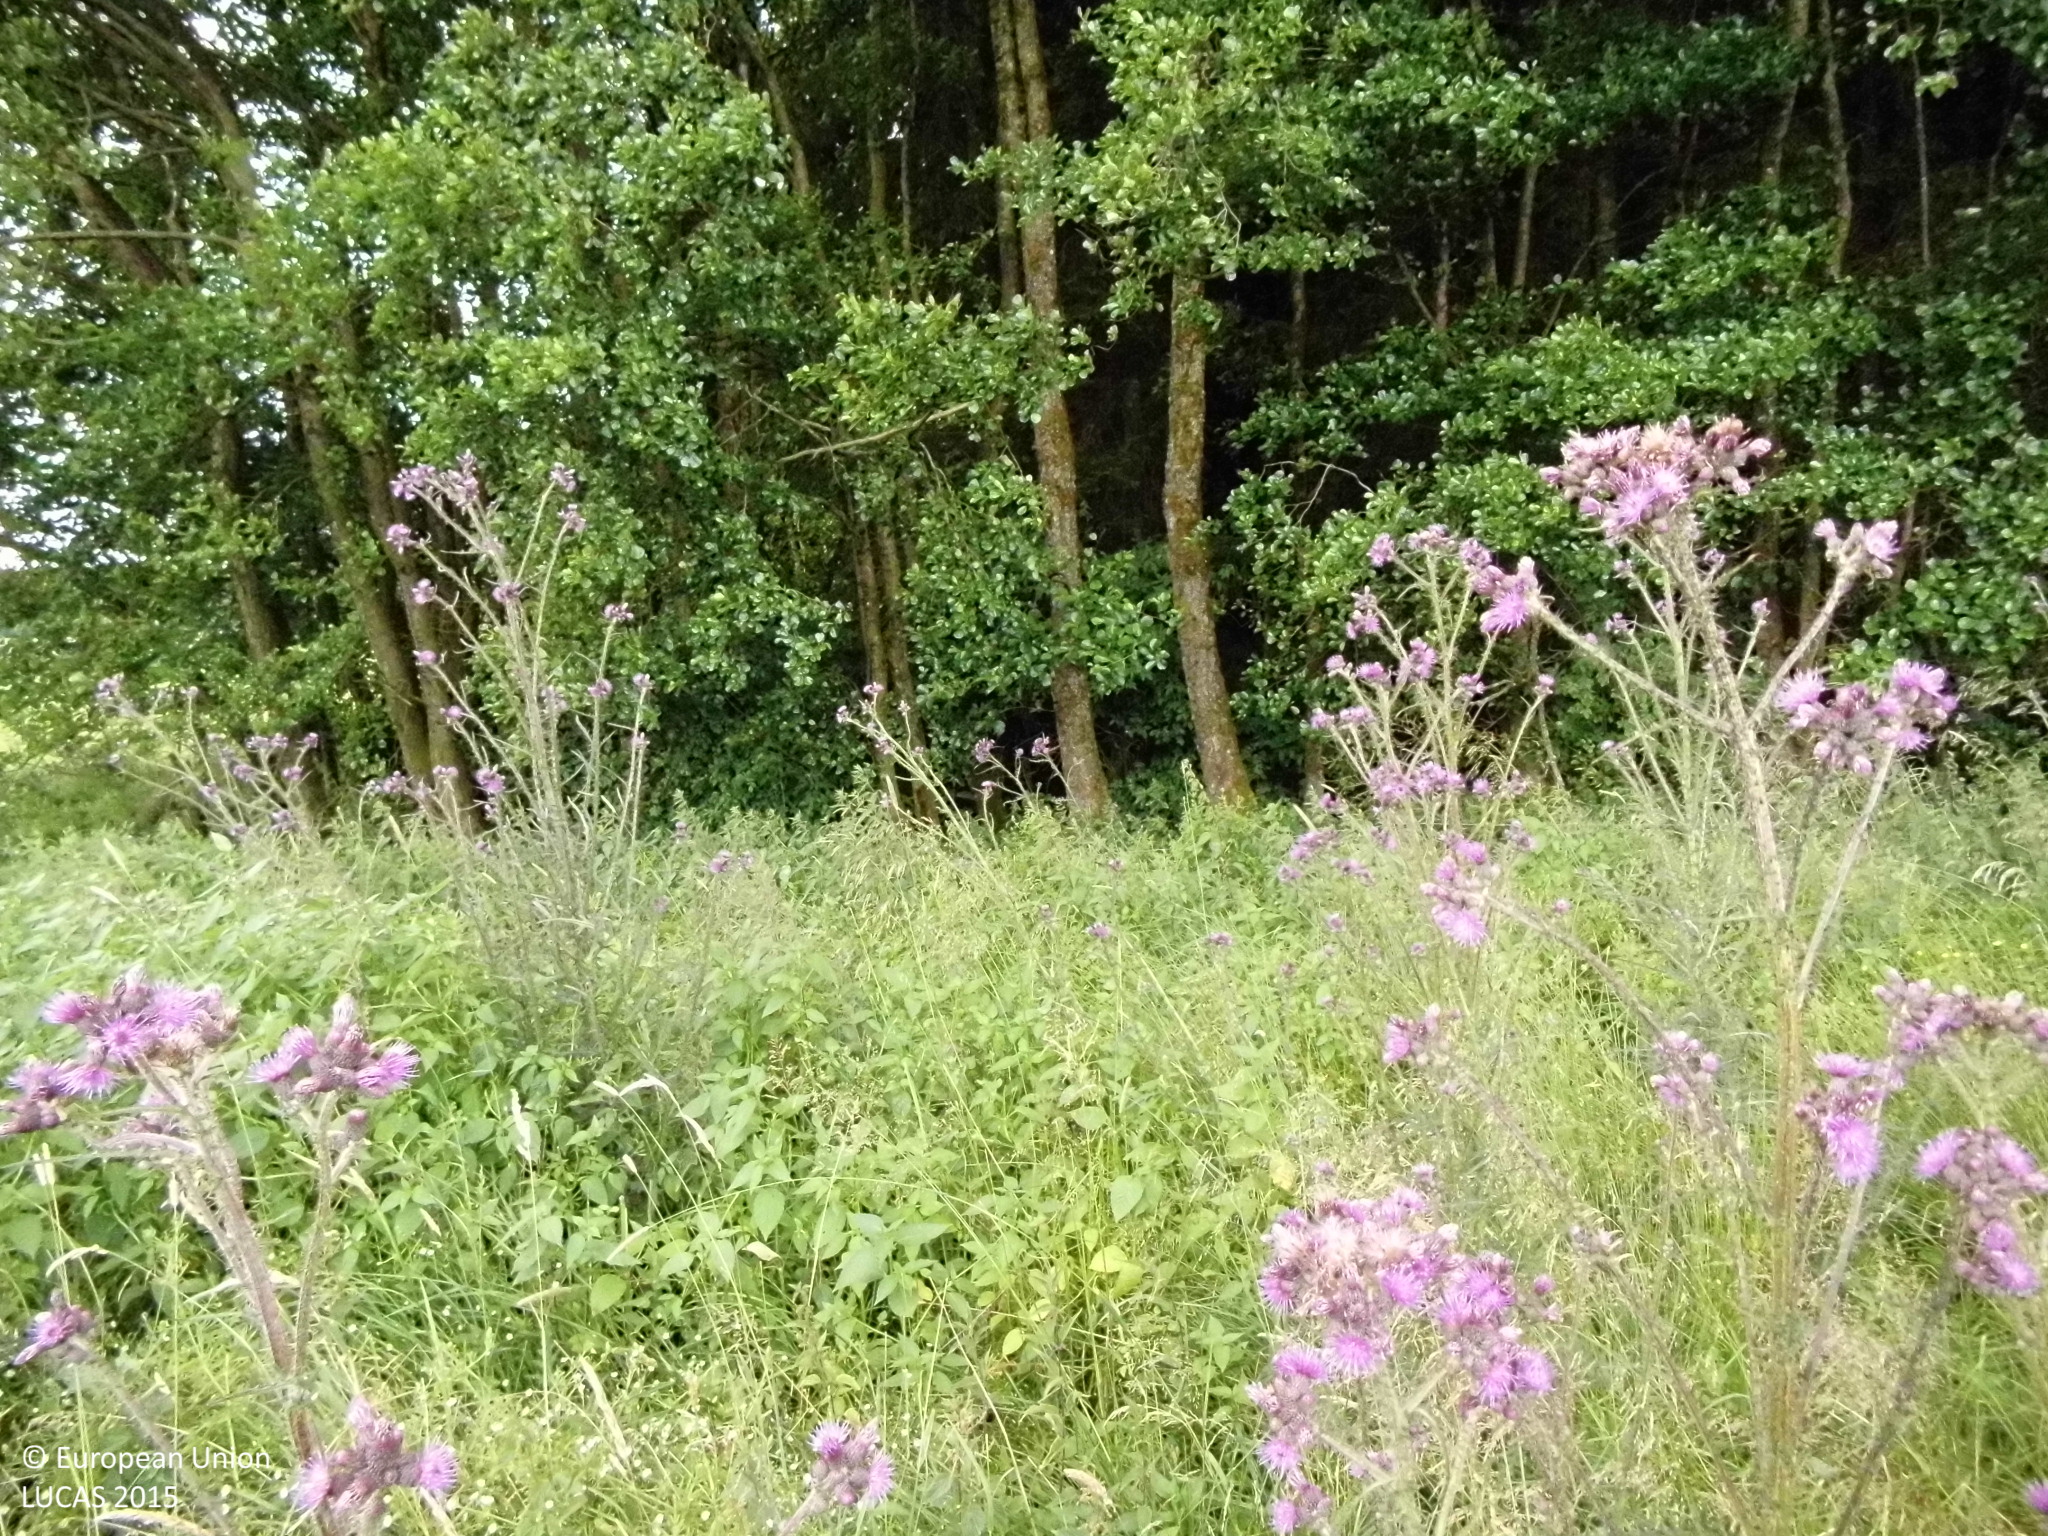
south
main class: Grassland
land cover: Spontaneously vegetated surfaces
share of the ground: 25 - 50 %
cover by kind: herbaceous plants 95 %, shrubs 5 %
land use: Agriculture (excluding fallow land and kitchen gardens)
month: July
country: DE
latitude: 50.6898
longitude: 8.0894
